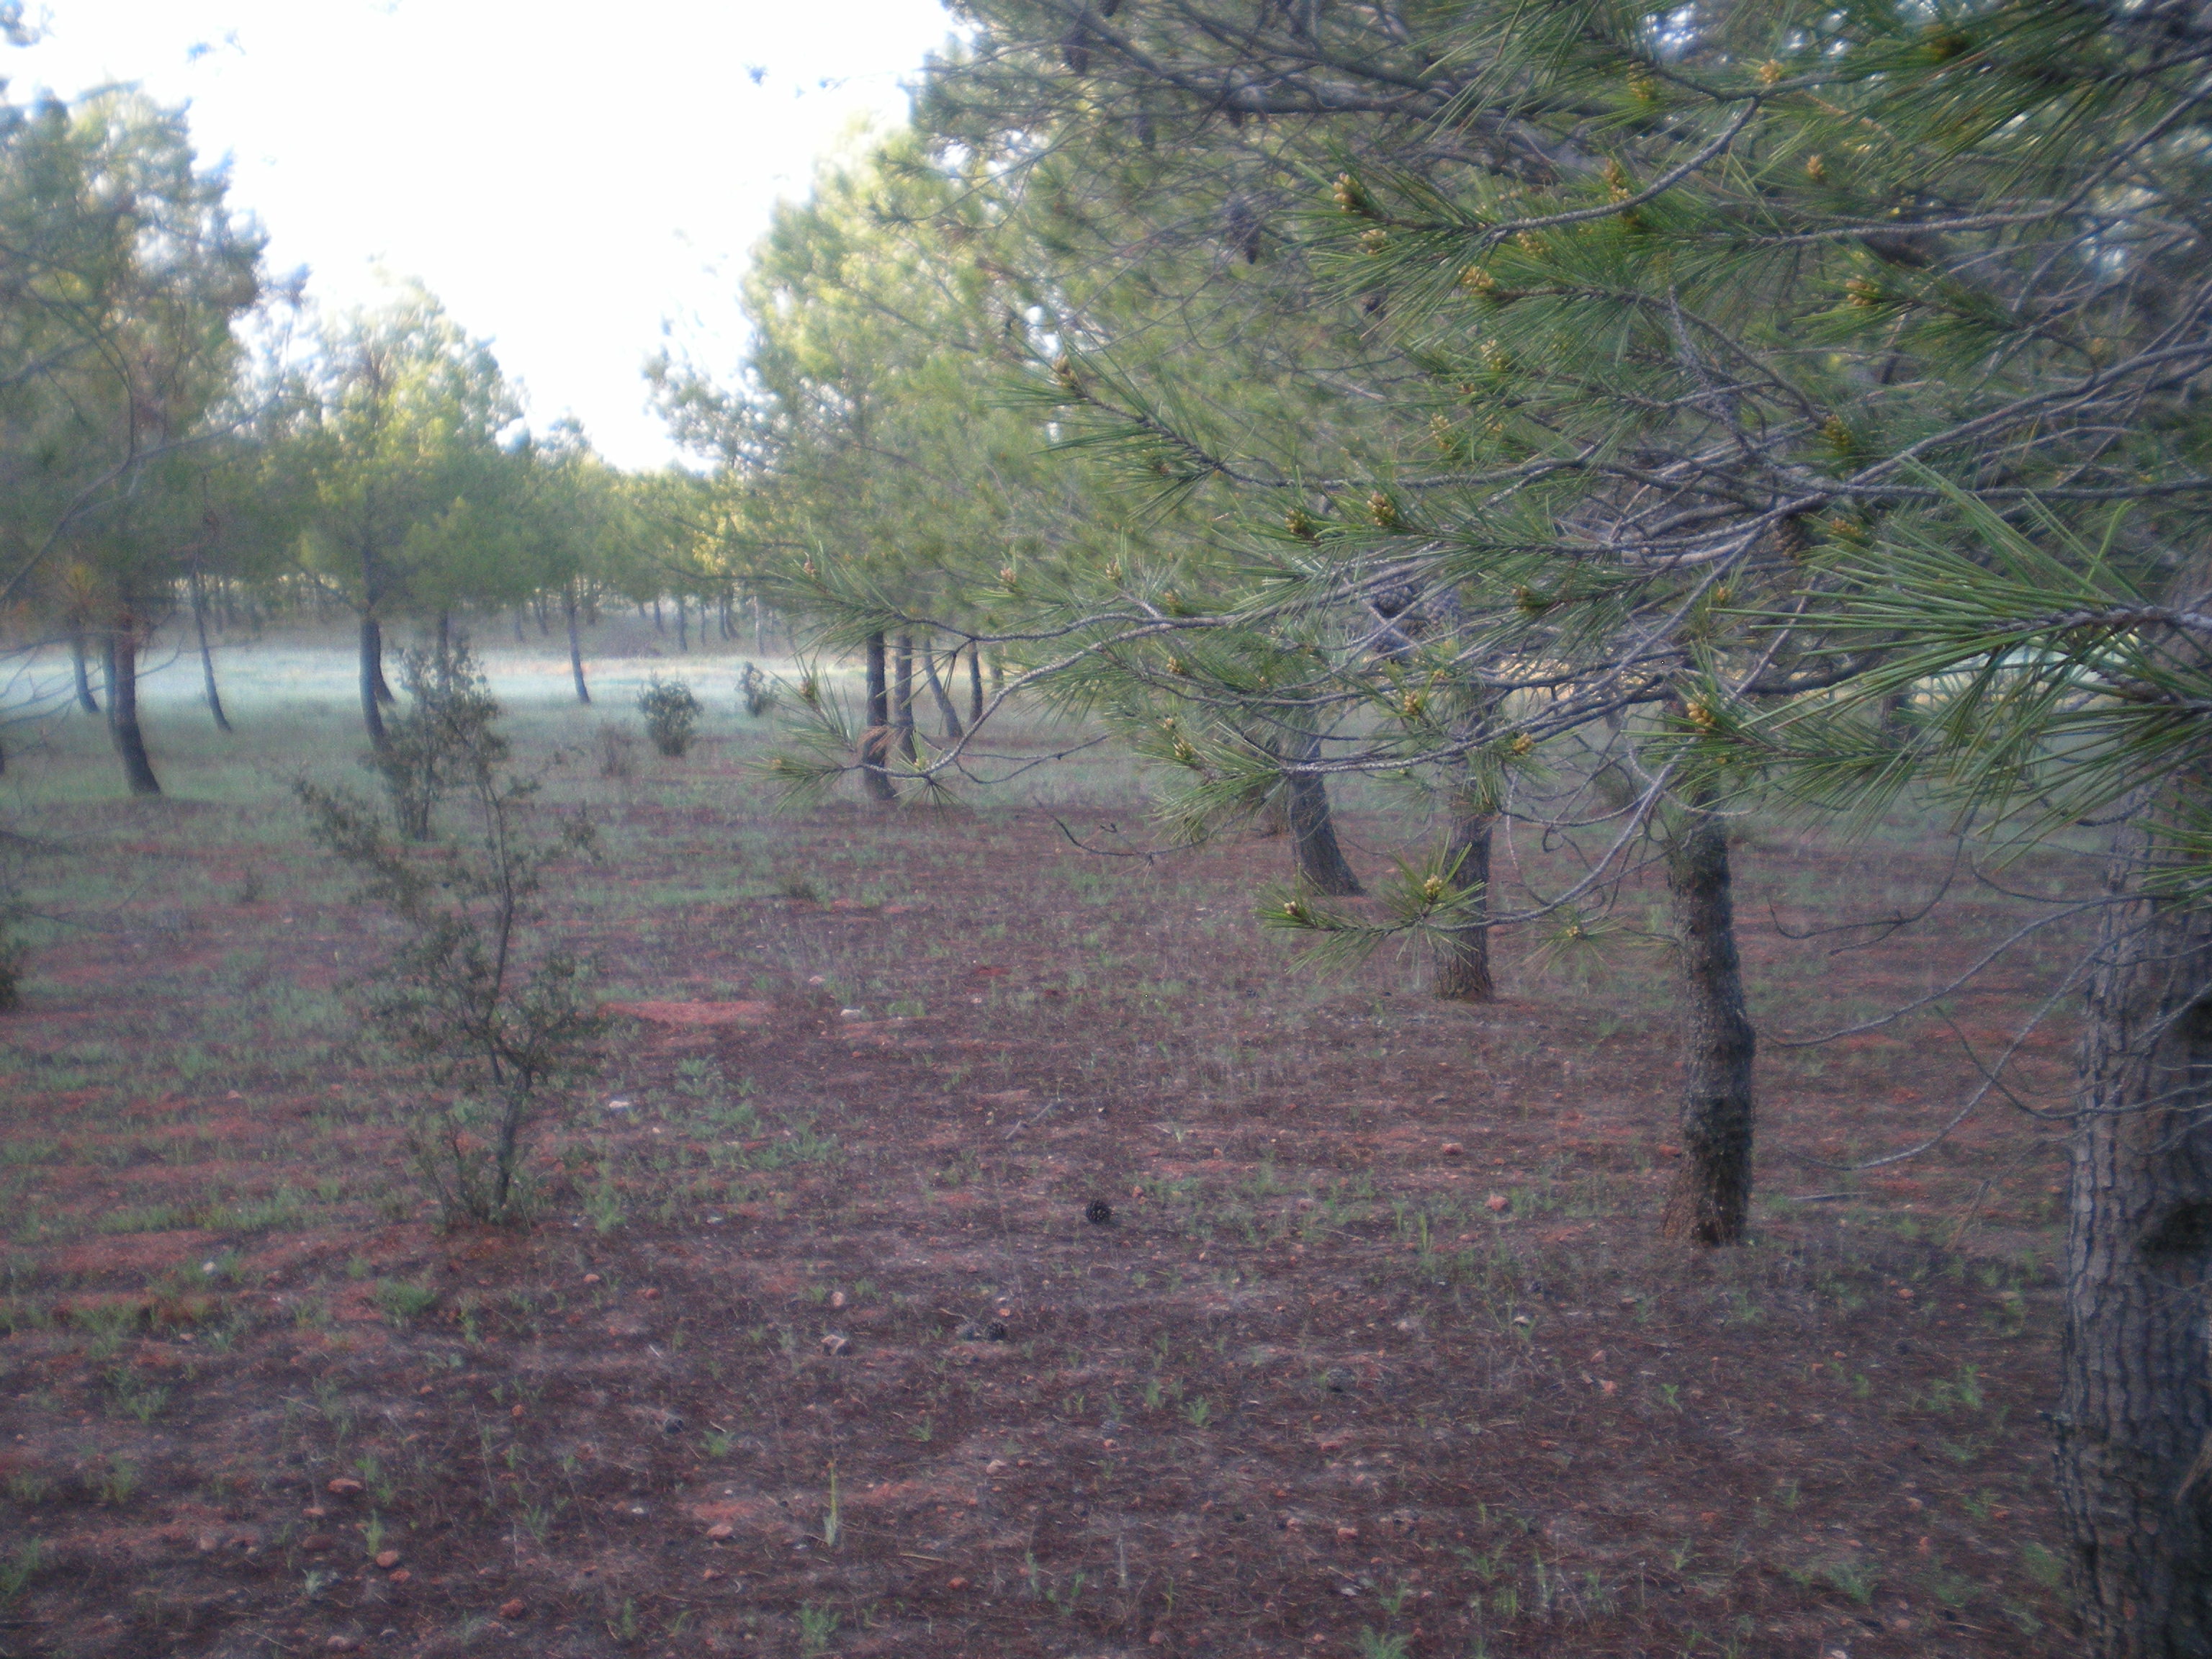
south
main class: Woodland
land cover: Pine dominated coniferous woodland
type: coniferous forest of the mediterranean region
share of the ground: 50 - 75 %
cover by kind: coniferous forest trees 60 %, herbaceous plants 25 %, unconsolidated bare surface 10 %, broadleaved forest trees 5 %
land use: Forestry
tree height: > 5 m
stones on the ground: < 10 %
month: April
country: ES
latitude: 38.6980
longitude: -3.0337
